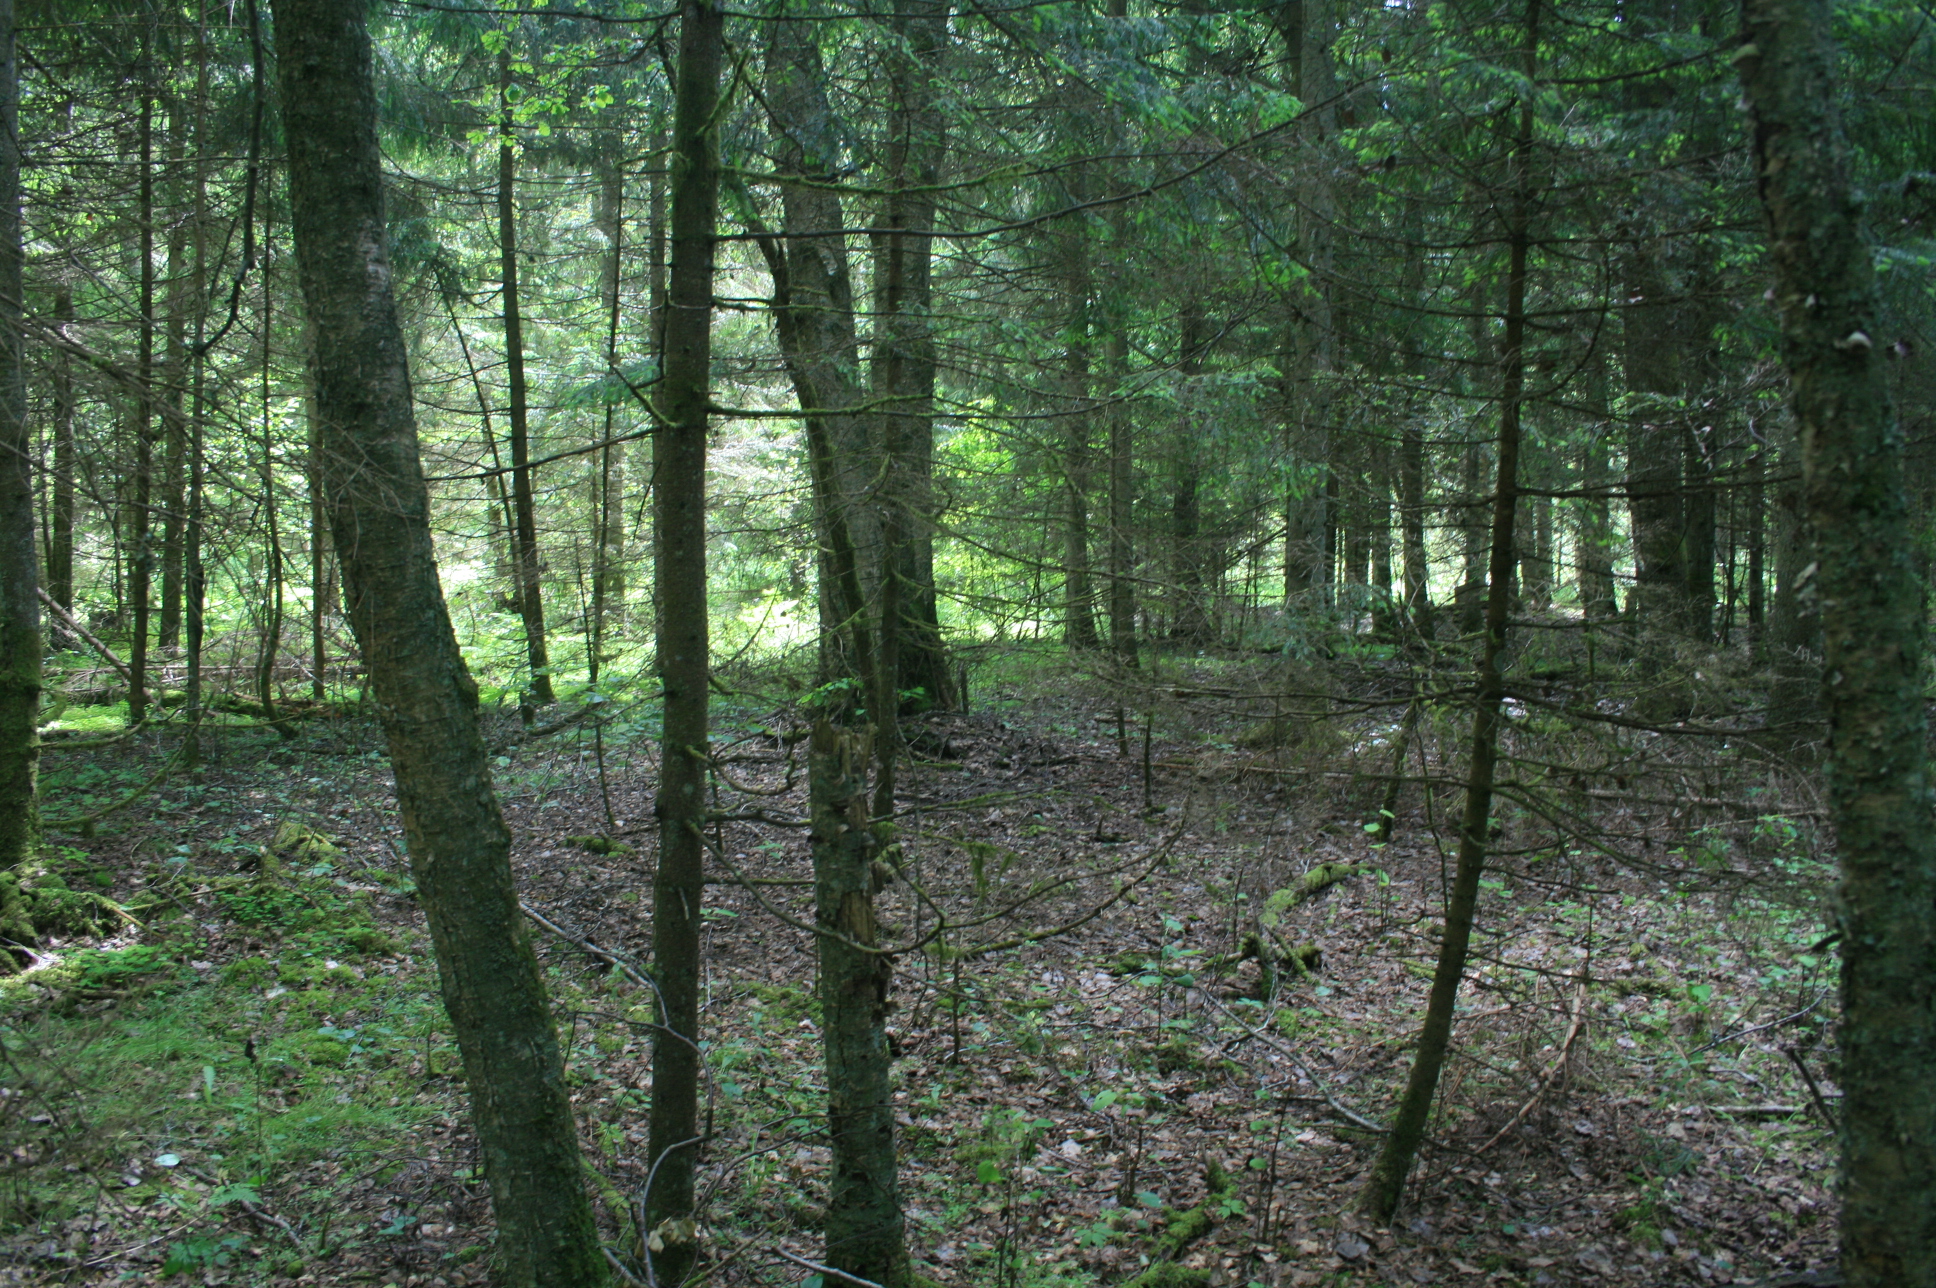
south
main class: Woodland
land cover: Spruce dominated mixed woodland
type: hemiboreal forest and nemoral coniferous forest and mixed broadleaved-coniferous forest
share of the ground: > 75 %
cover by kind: broadleaved forest trees 50 %, coniferous forest trees 40 %, herbaceous plants 10 %
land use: Forestry
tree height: > 5 m
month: June
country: LT
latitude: 55.2996
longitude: 22.1366
